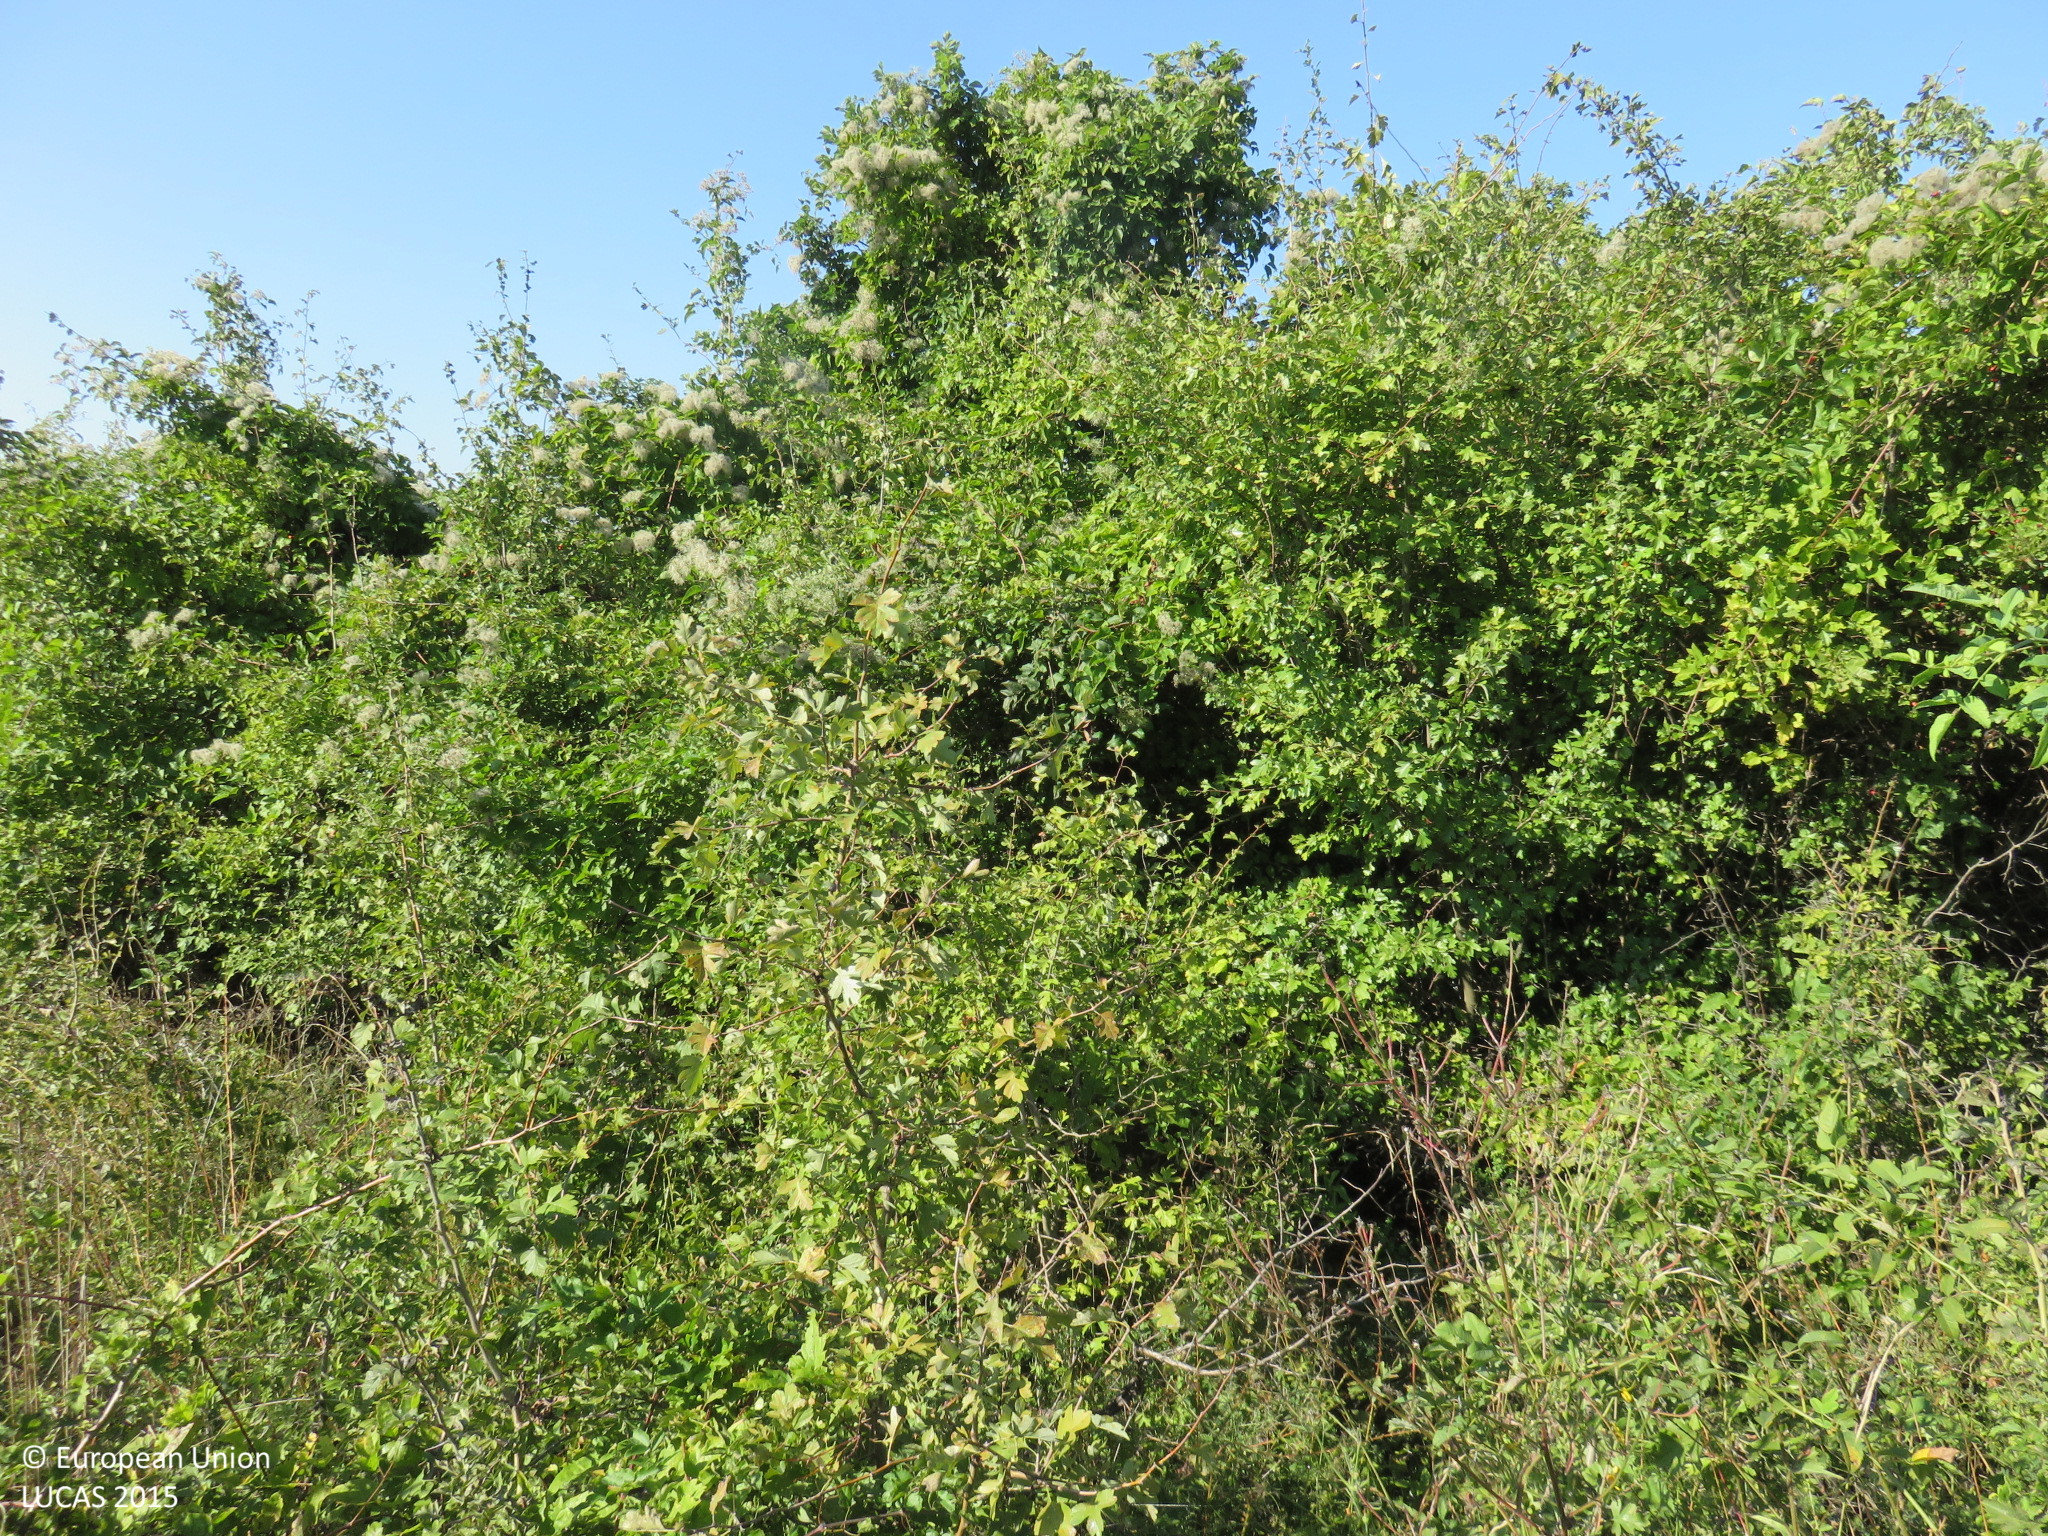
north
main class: Woodland
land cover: Broadleaved woodland
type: mesophytic deciduous forest
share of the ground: 50 - 75 %
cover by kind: broadleaved forest trees 70 %, shrubs 30 %
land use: Semi-natural and natural areas not in use
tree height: < 5 m
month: September
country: BG
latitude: 43.6610
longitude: 24.4594
